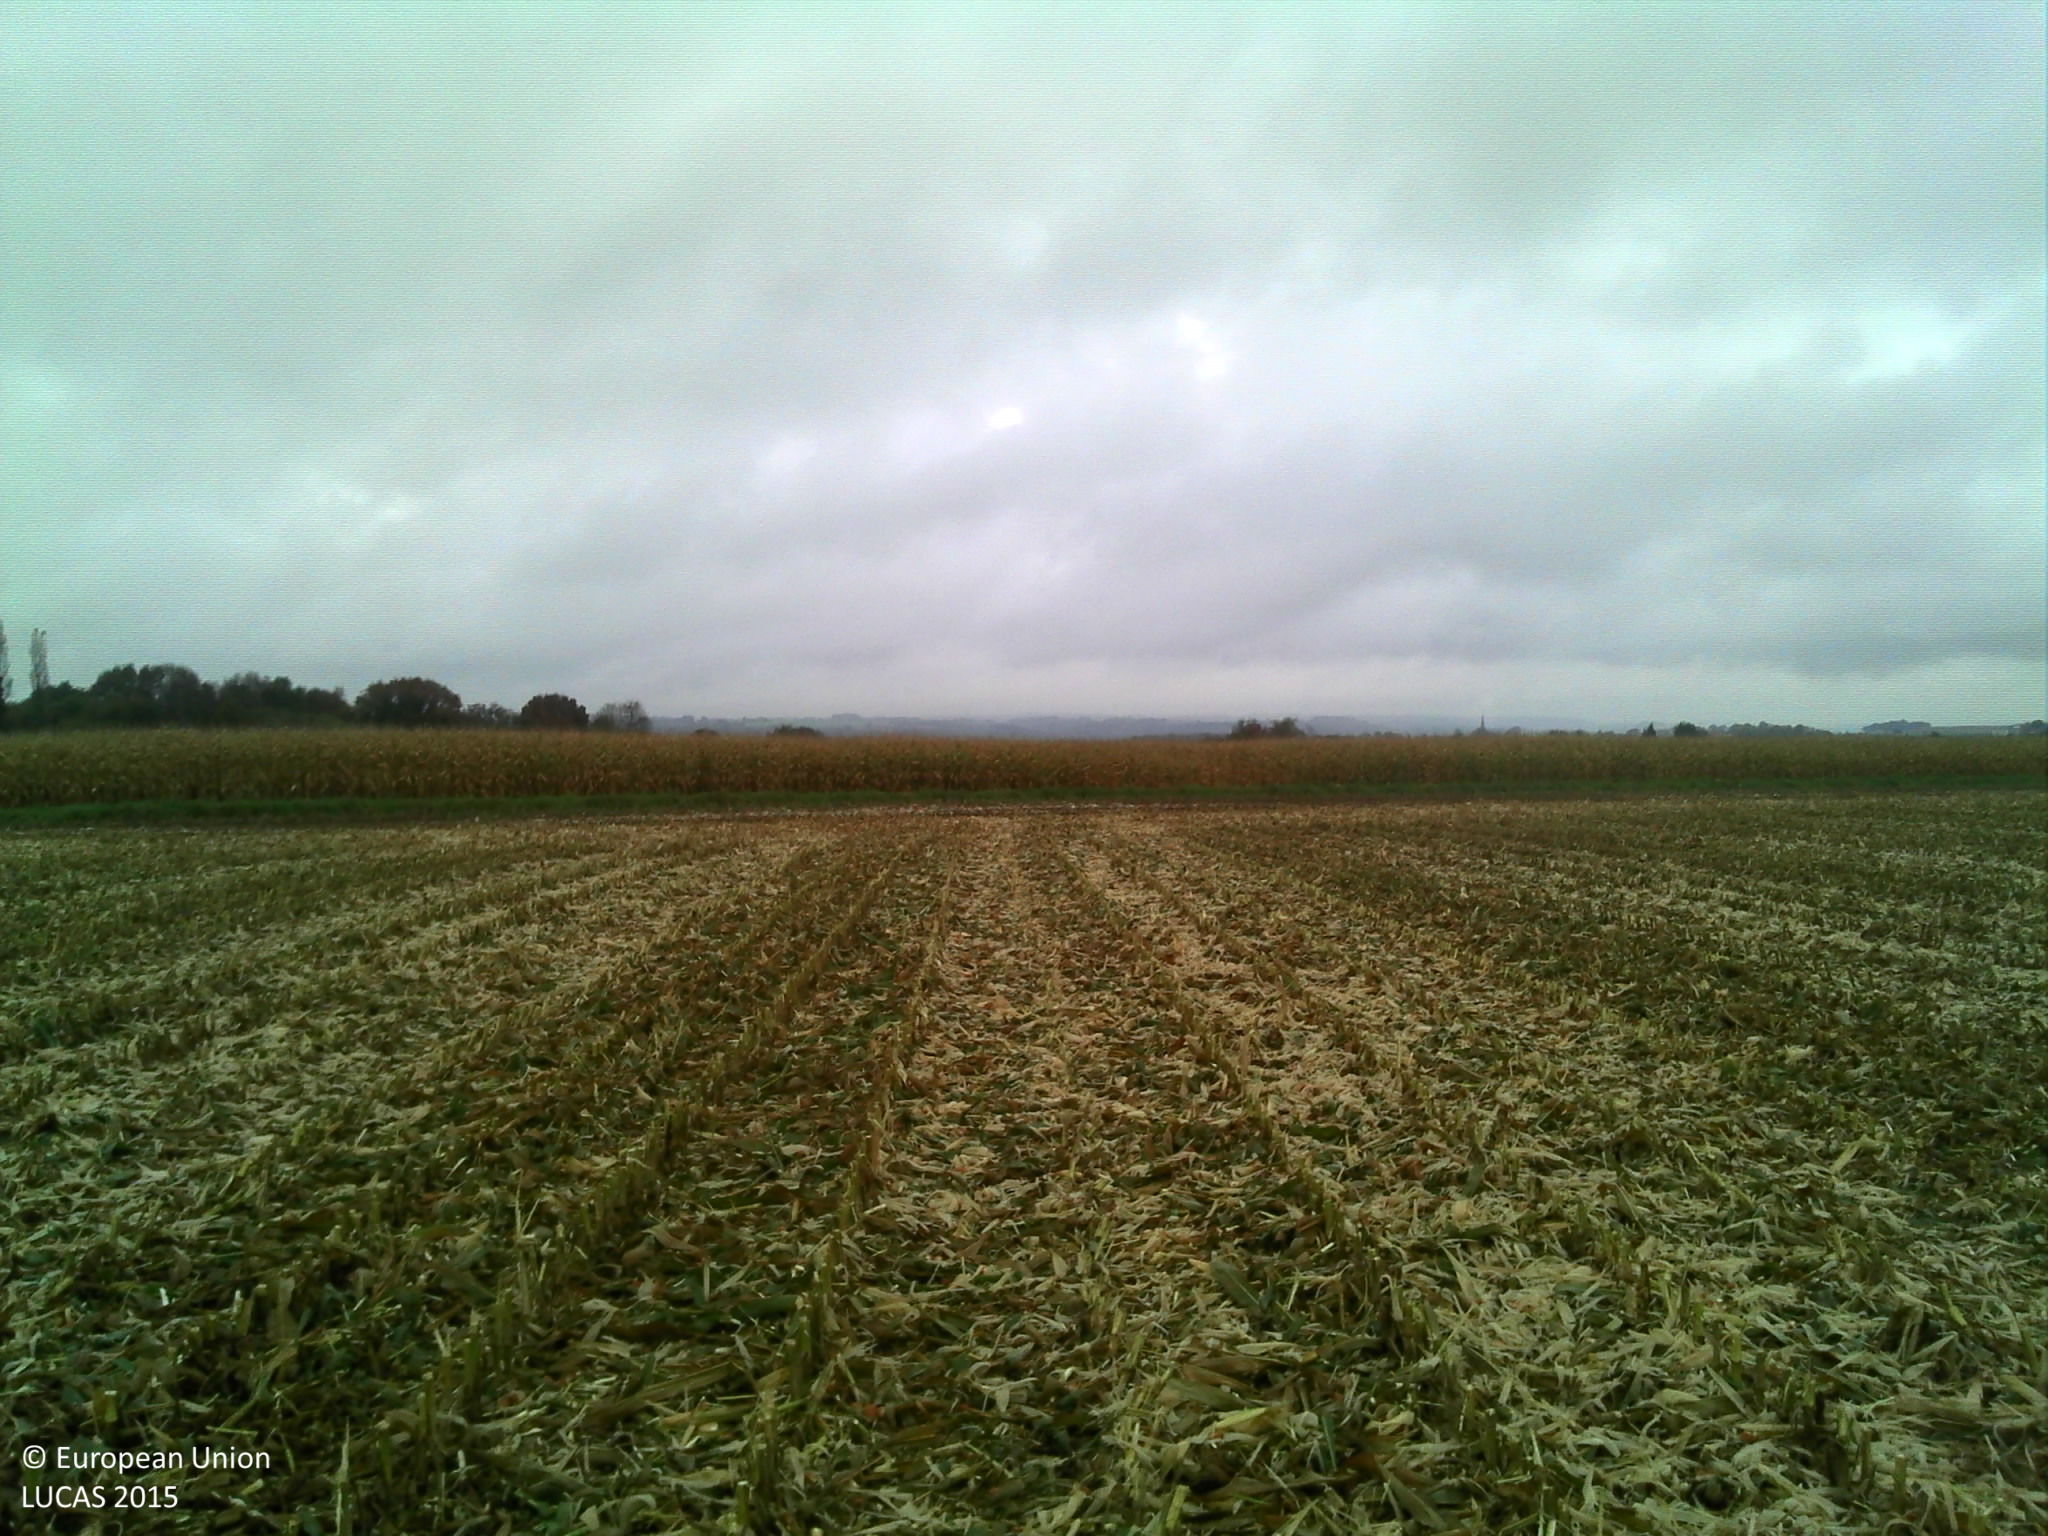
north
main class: Cropland
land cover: Maize
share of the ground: > 75 %
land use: Agriculture (excluding fallow land and kitchen gardens)
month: November
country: FR
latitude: 47.9580
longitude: -3.0176
